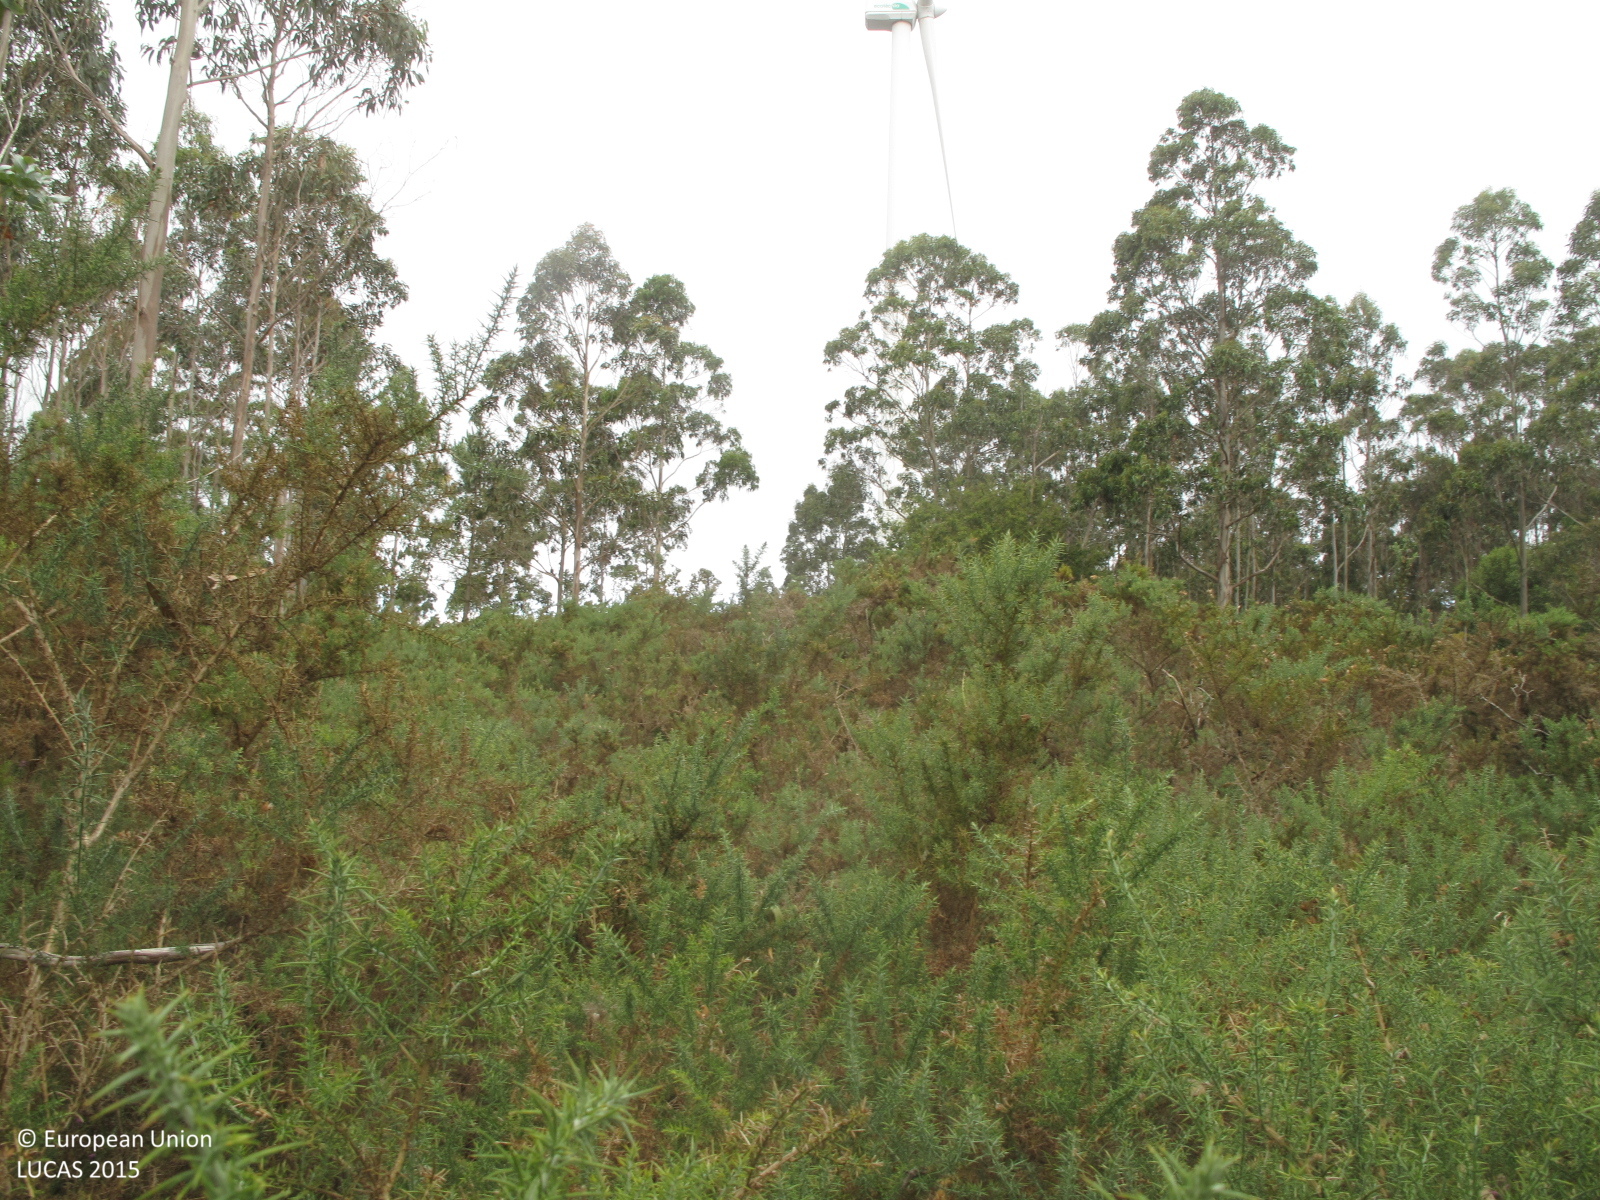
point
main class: Woodland
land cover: Broadleaved woodland
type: exotic forest
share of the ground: 25 - 50 %
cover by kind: shrubs 60 %, broadleaved forest trees 30 %, herbaceous plants 10 %
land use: Forestry
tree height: > 5 m
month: July
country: ES
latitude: 43.5873
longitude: -8.1215
